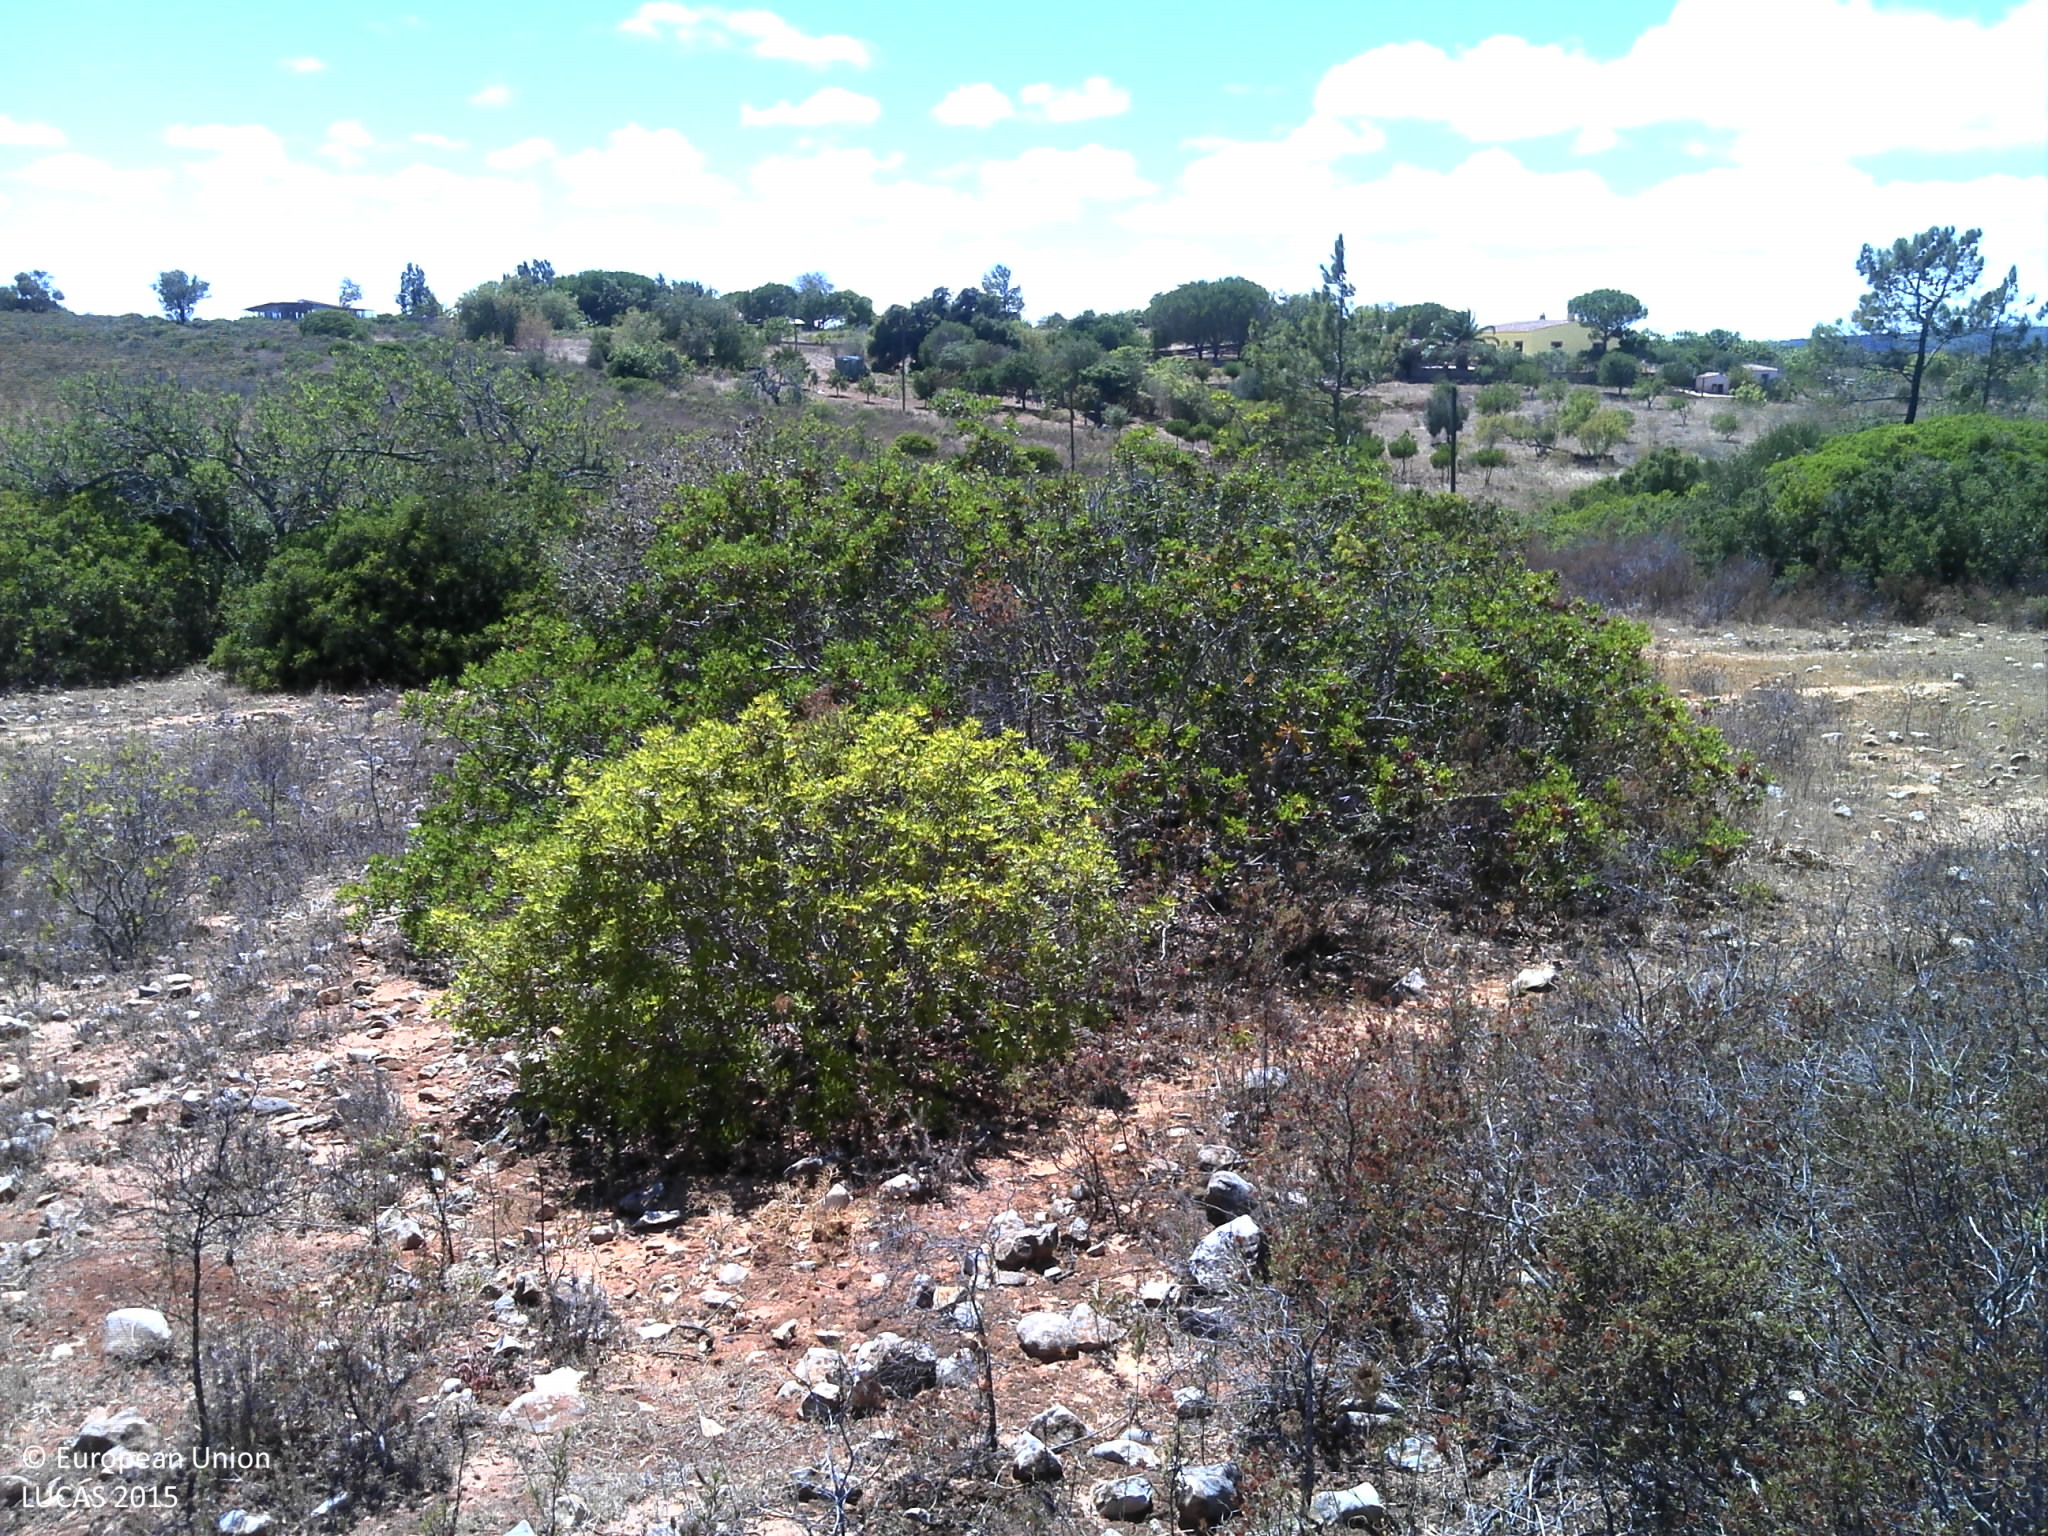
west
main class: Grassland
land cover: Grassland with sparse tree/shrub cover
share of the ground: 50 - 75 %
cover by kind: herbaceous plants 60 %, unconsolidated bare surface 30 %, broadleaved forest trees 5 %, shrubs 5 %
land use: Agriculture (excluding fallow land and kitchen gardens)
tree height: < 5 m
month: July
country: PT
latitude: 37.1260
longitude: -8.7485
